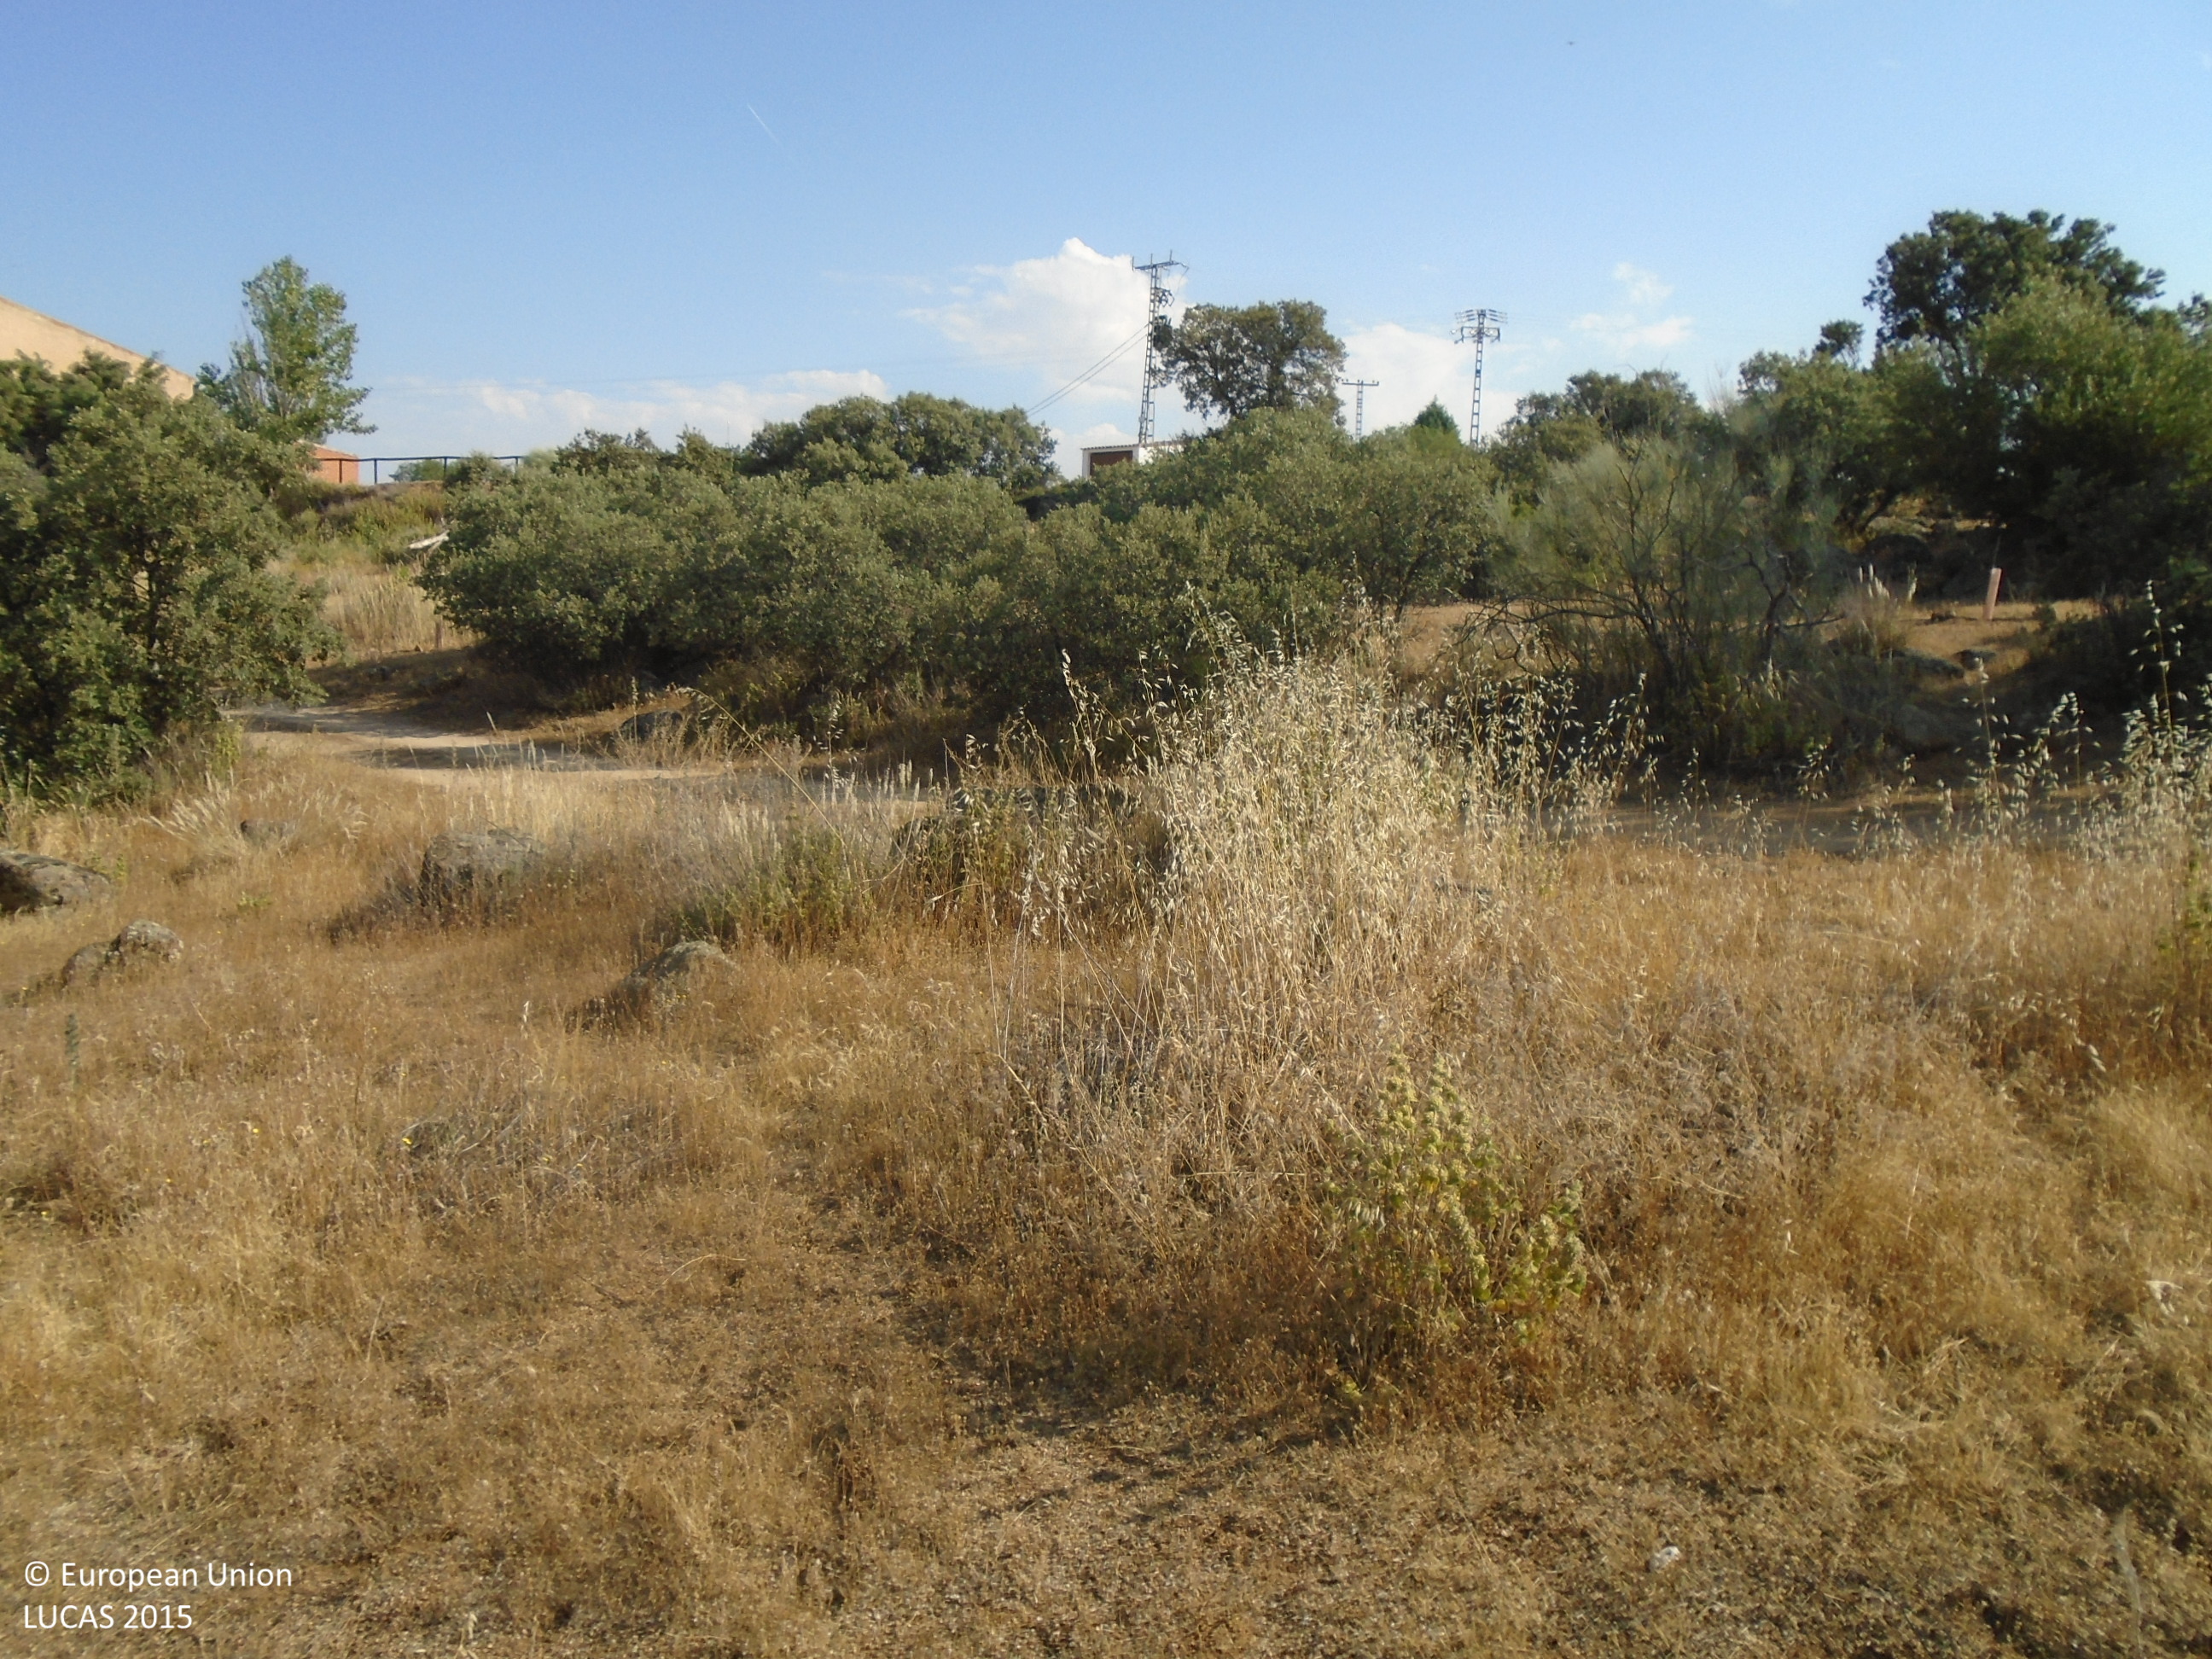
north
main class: Woodland
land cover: Broadleaved woodland
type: broadleaved evergreen forest
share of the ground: > 75 %
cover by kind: broadleaved forest trees 90 %, shrubs 10 %
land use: Semi-natural and natural areas not in use
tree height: > 5 m
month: June
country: ES
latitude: 39.7901
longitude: -4.2481
